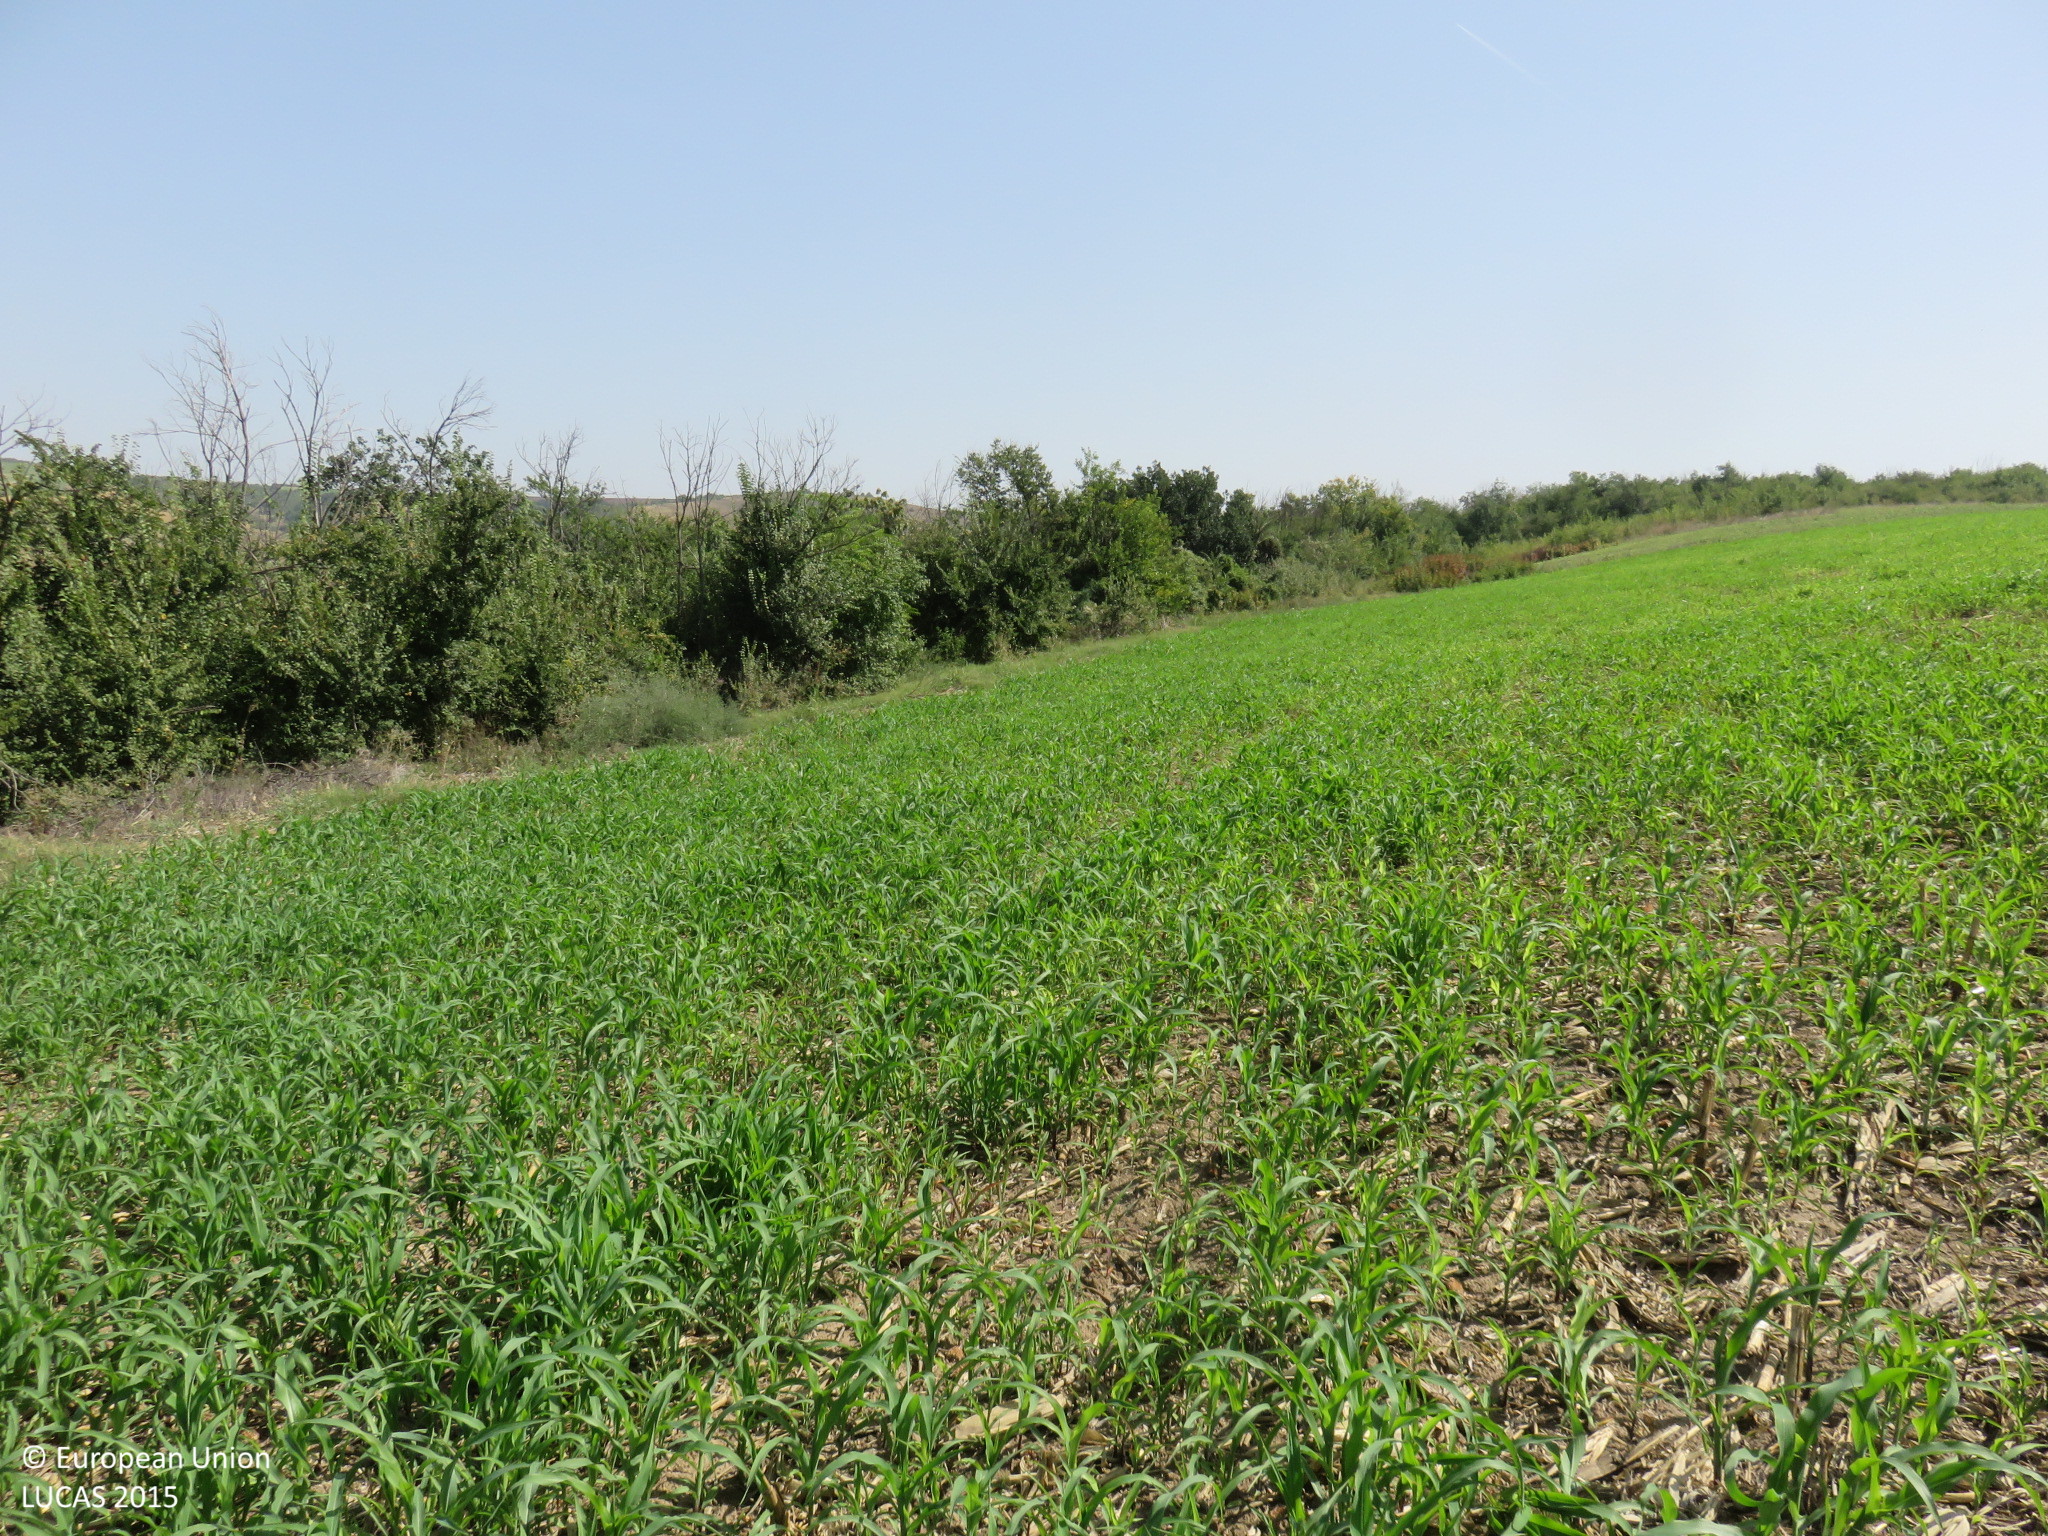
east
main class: Cropland
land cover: Maize
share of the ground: 25 - 50 %
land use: Agriculture (excluding fallow land and kitchen gardens)
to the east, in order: Maize; Grass margins; Broadleaved woodland
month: September
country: BG
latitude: 43.5448
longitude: 24.6318
